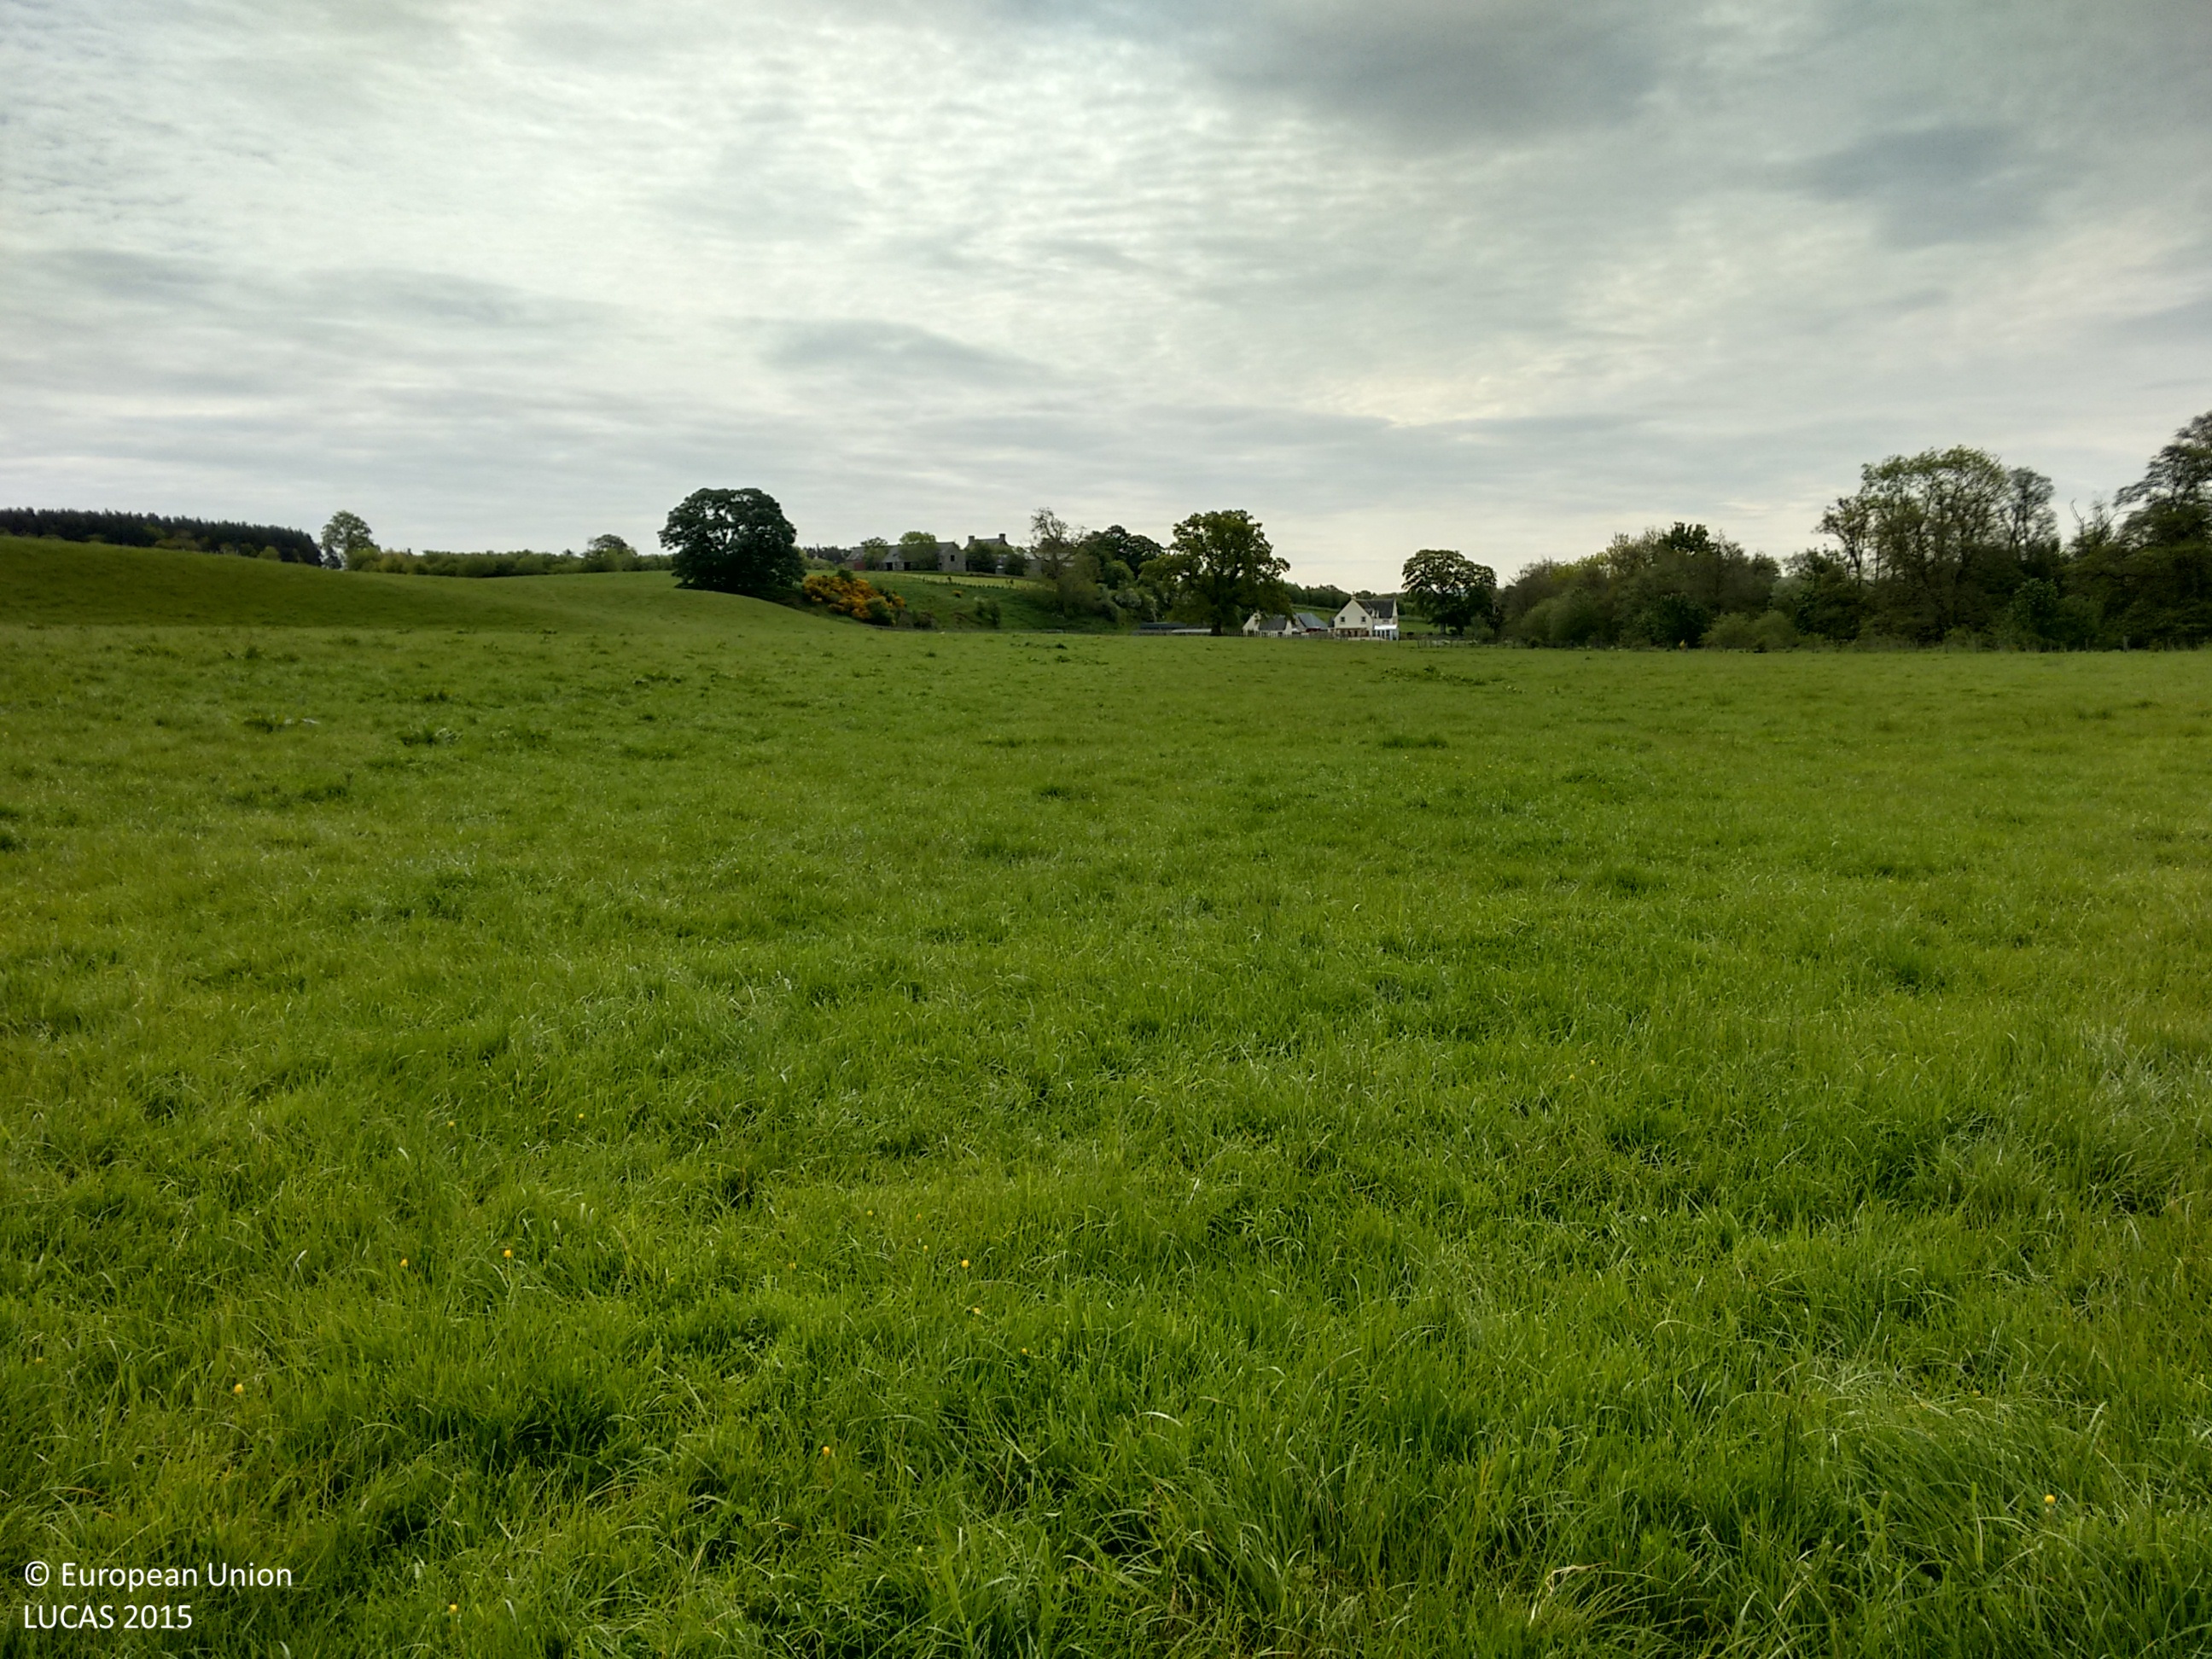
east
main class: Grassland
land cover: Grassland without tree/shrub cover
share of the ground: > 75 %
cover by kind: herbaceous plants 100 %
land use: Agriculture (excluding fallow land and kitchen gardens)
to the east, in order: Fences; Grassland without tree/shrub cover
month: June
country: GB
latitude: 56.4533
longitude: -3.5266
